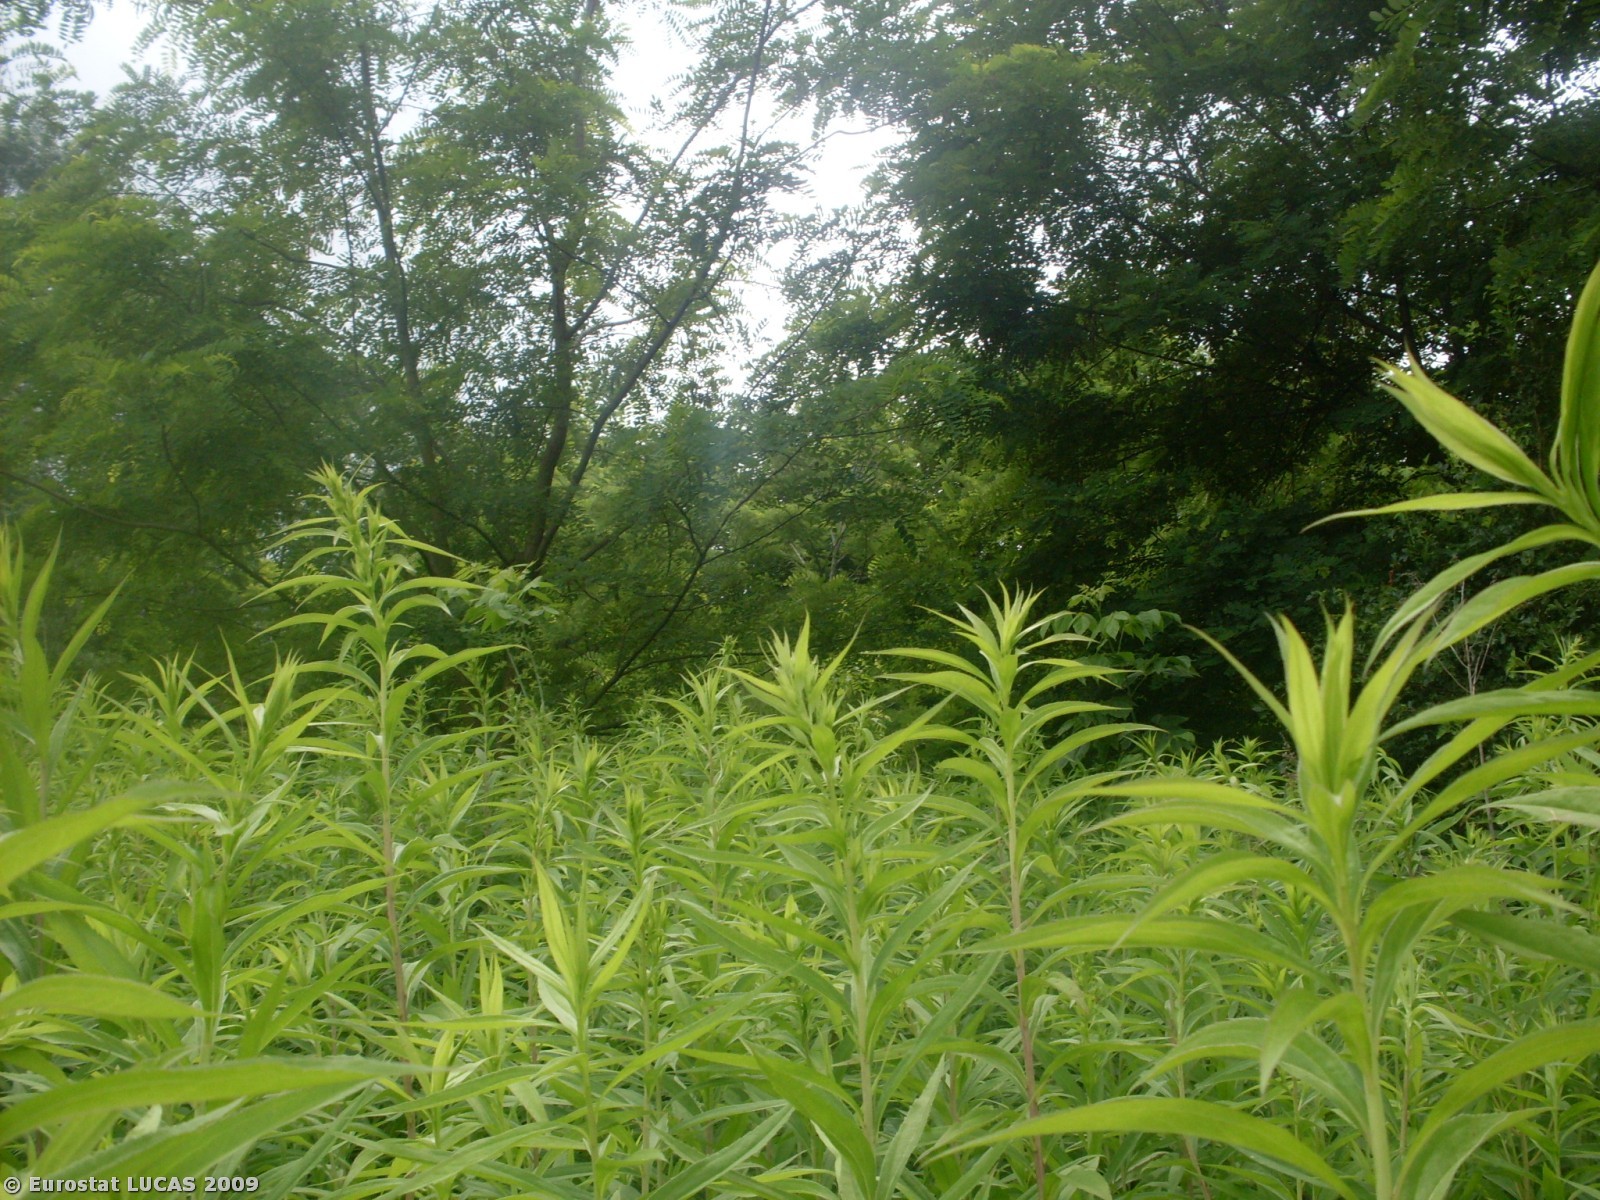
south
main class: Grassland
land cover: Spontaneously vegetated surfaces
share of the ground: > 75 %
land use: Unused
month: July
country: PL
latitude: 50.1470
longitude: 20.5477
